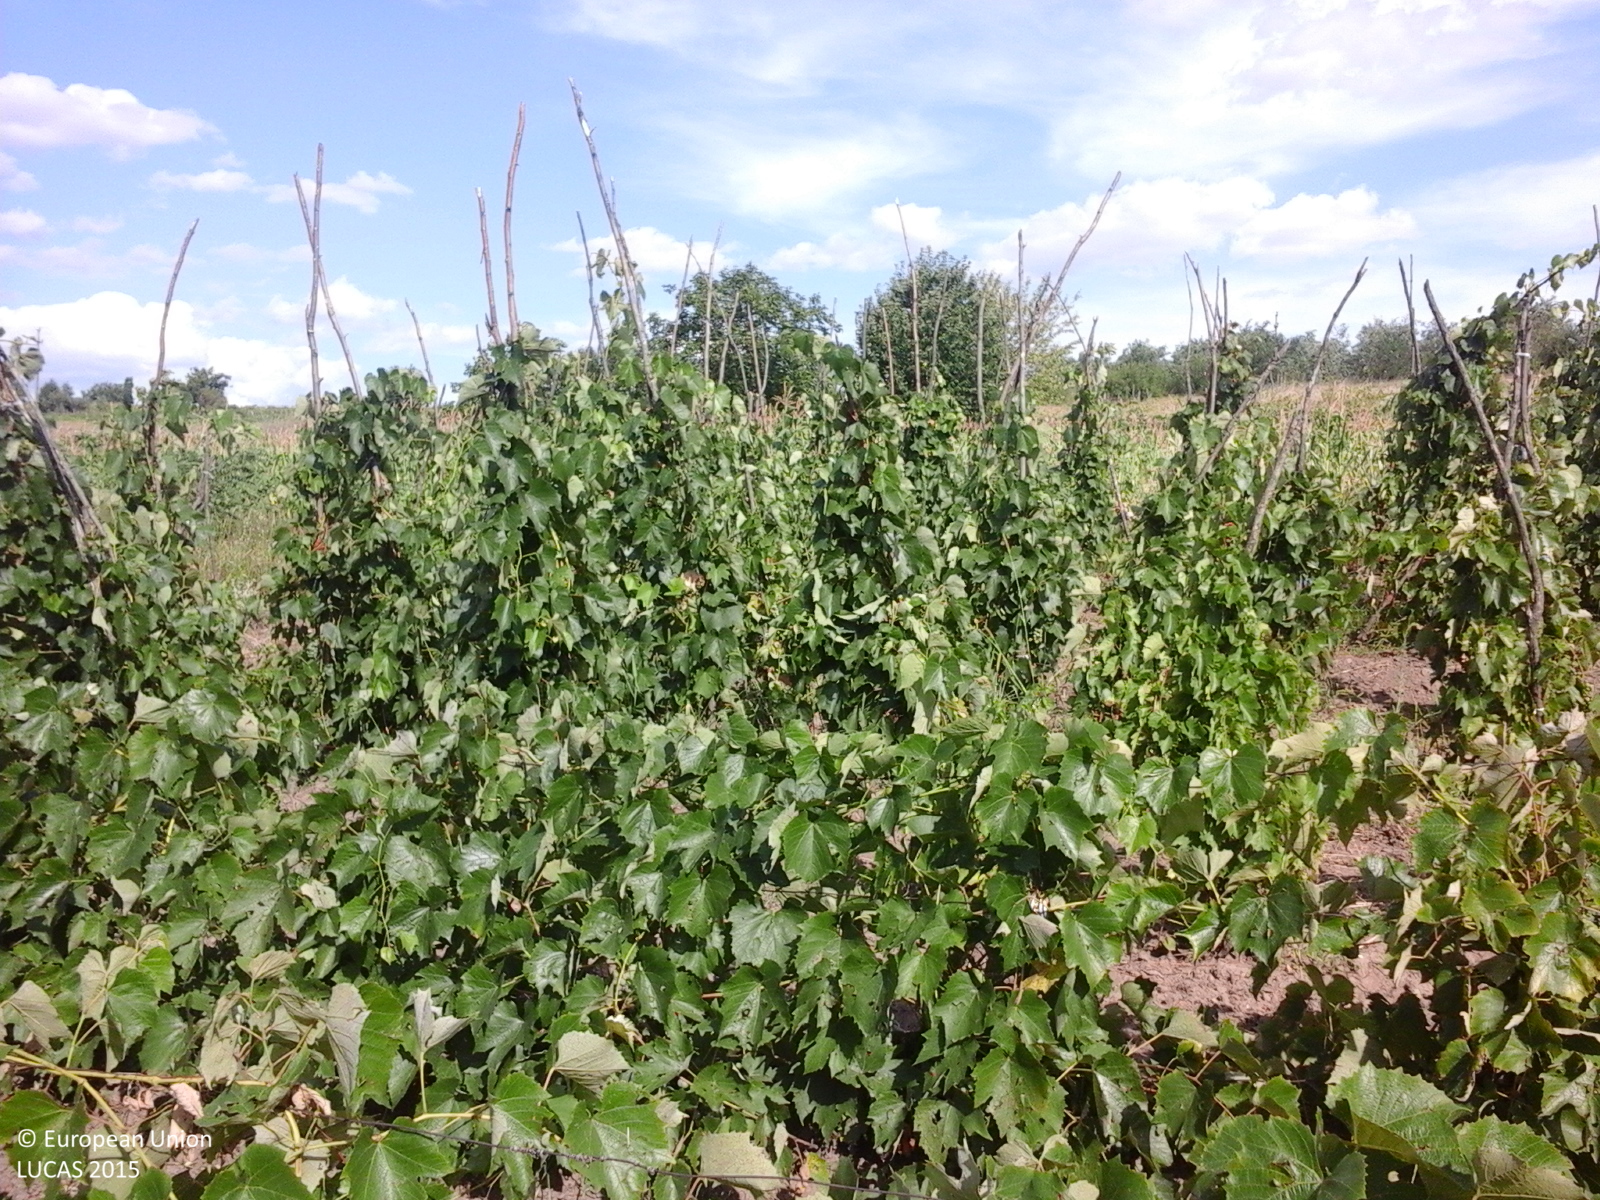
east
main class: Cropland
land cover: Vineyards
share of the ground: > 75 %
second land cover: Grassland without tree/shrub cover
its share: > 75 %
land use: Agriculture (excluding fallow land and kitchen gardens)
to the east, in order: Vineyards; Grassland without tree/shrub cover; Maize; Vineyards; Electric lines; Lines of trees; Grass margins; Tracks; Grass margins; Vineyards; Grassland without tree/shrub cover; Vineyards; Electric lines; Vineyards; Maize; Vineyards
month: July
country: RO
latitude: 46.0475
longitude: 27.6488
